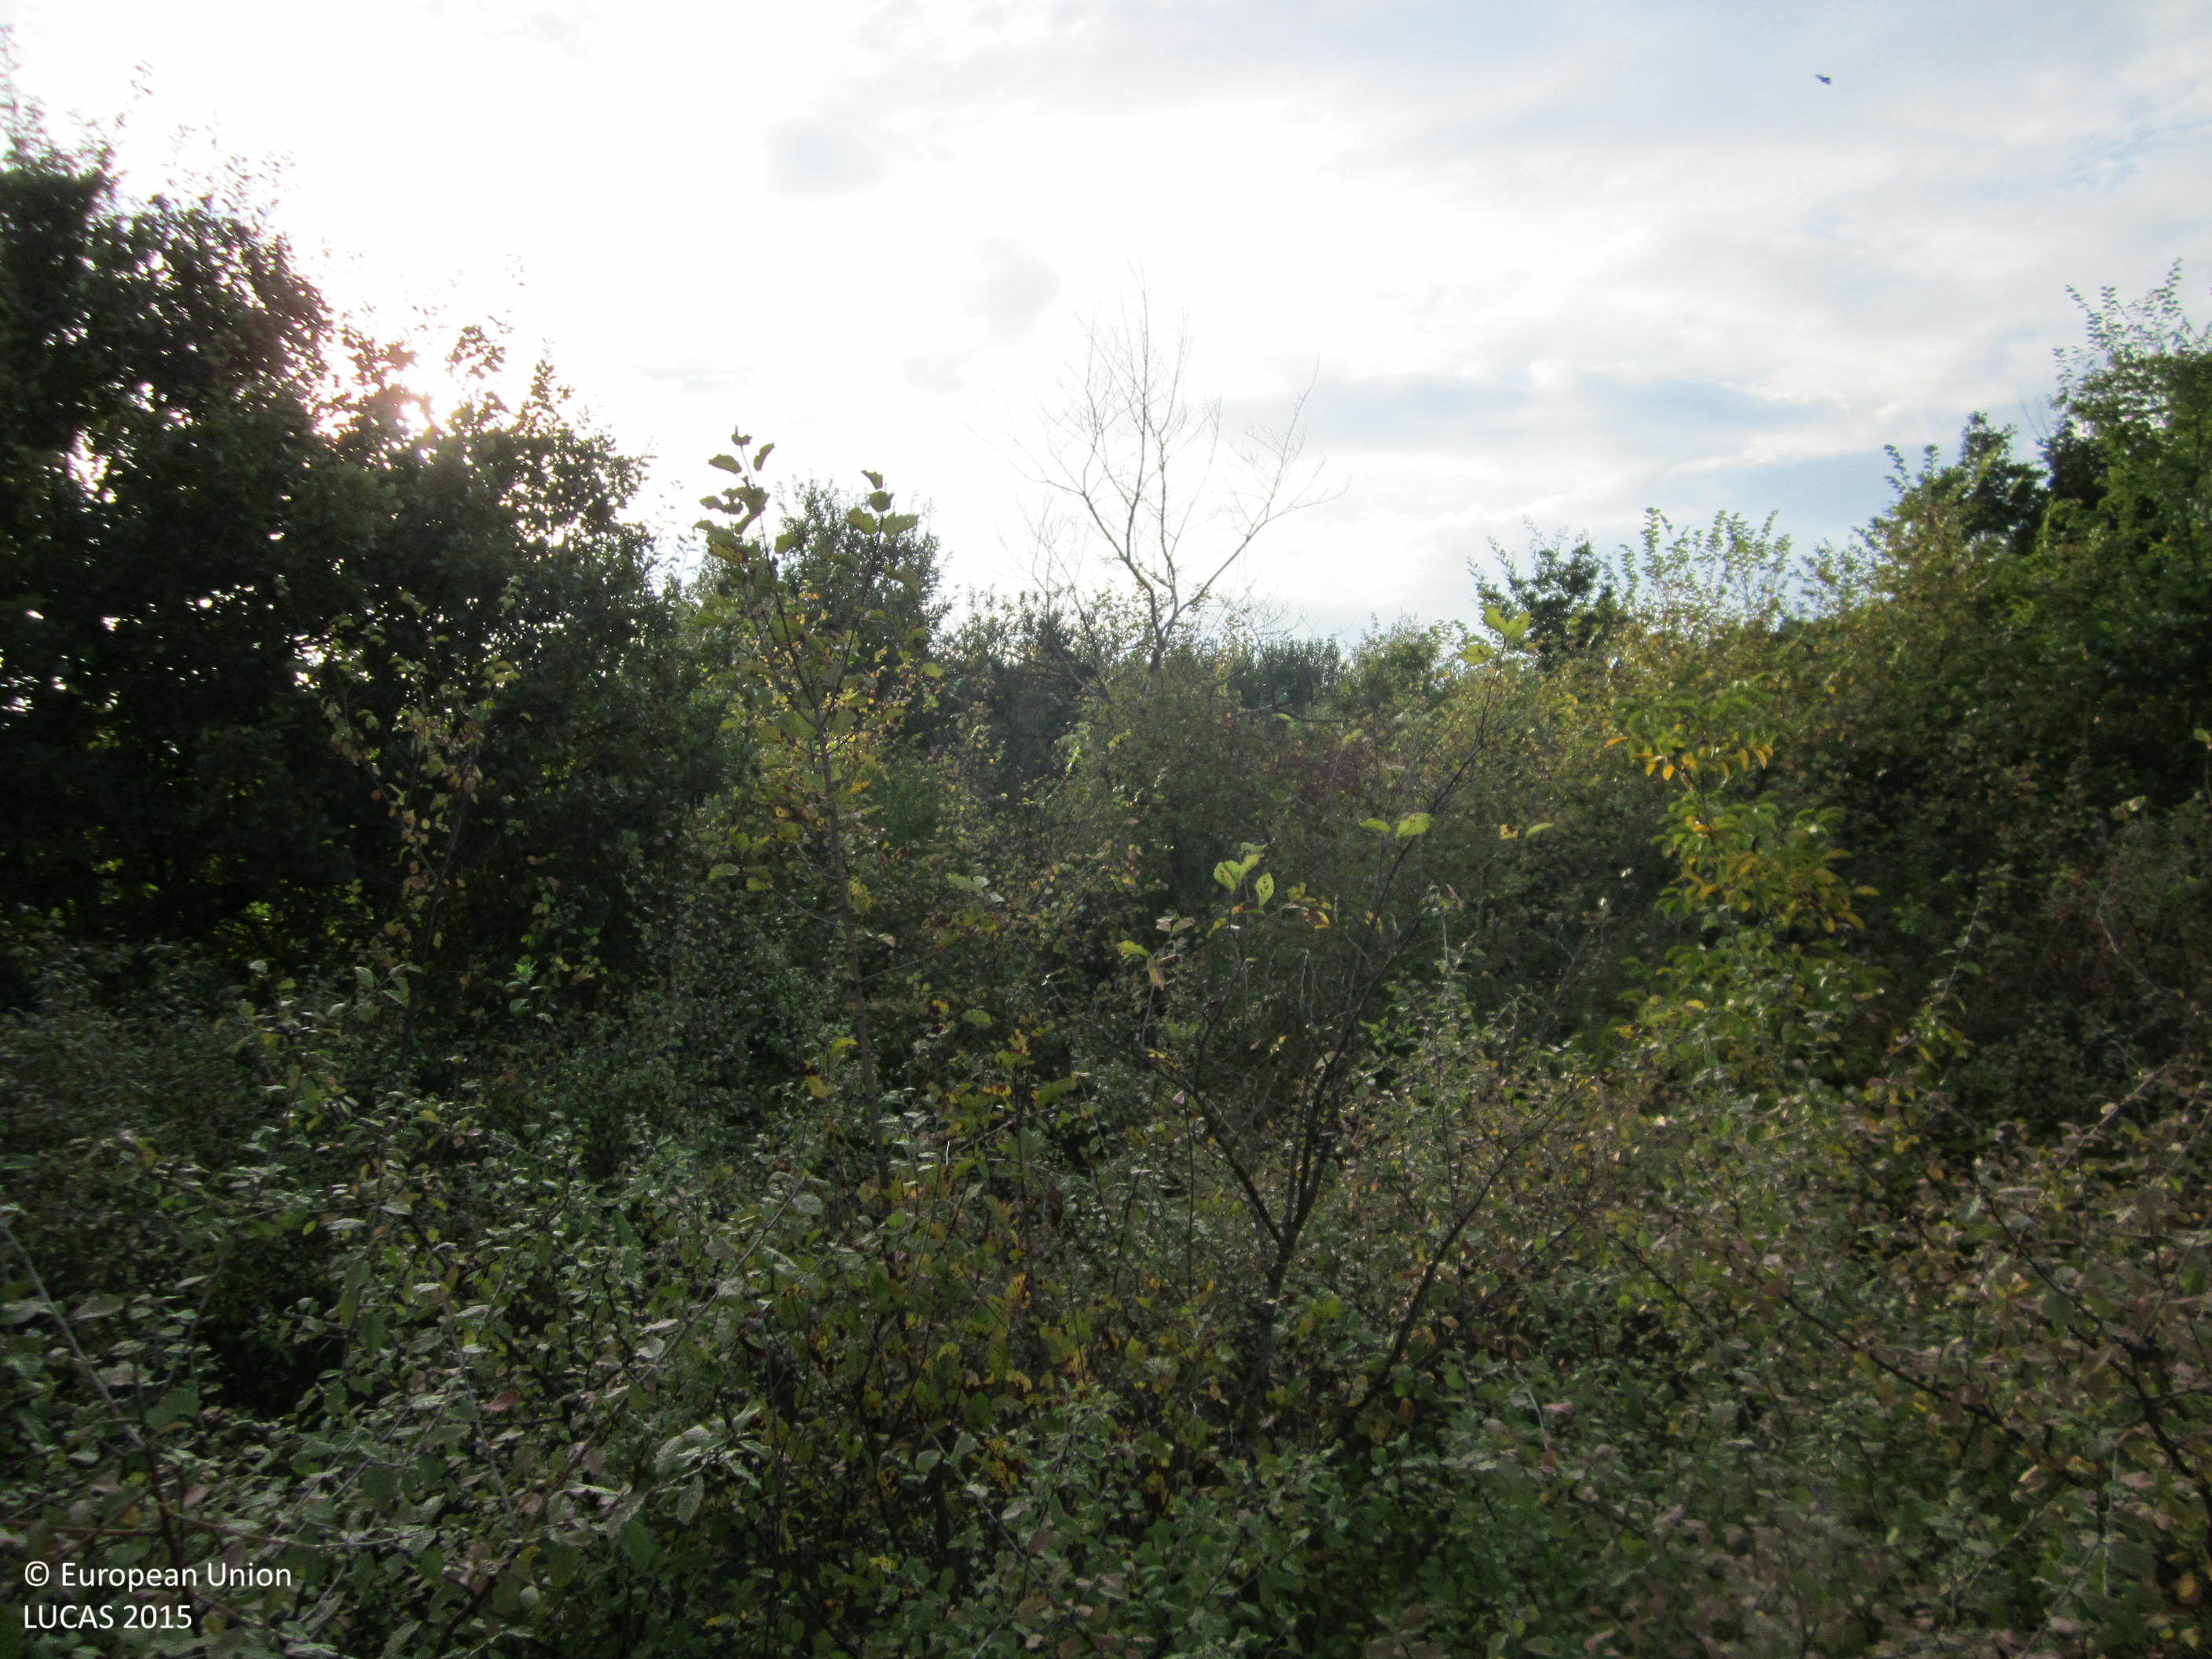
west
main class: Shrubland
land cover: Shrubland with sparse tree cover
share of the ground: 50 - 75 %
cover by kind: shrubs 70 %, herbaceous plants 25 %, broadleaved forest trees 5 %
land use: Semi-natural and natural areas not in use
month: October
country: BG
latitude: 42.7244
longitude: 26.7215
